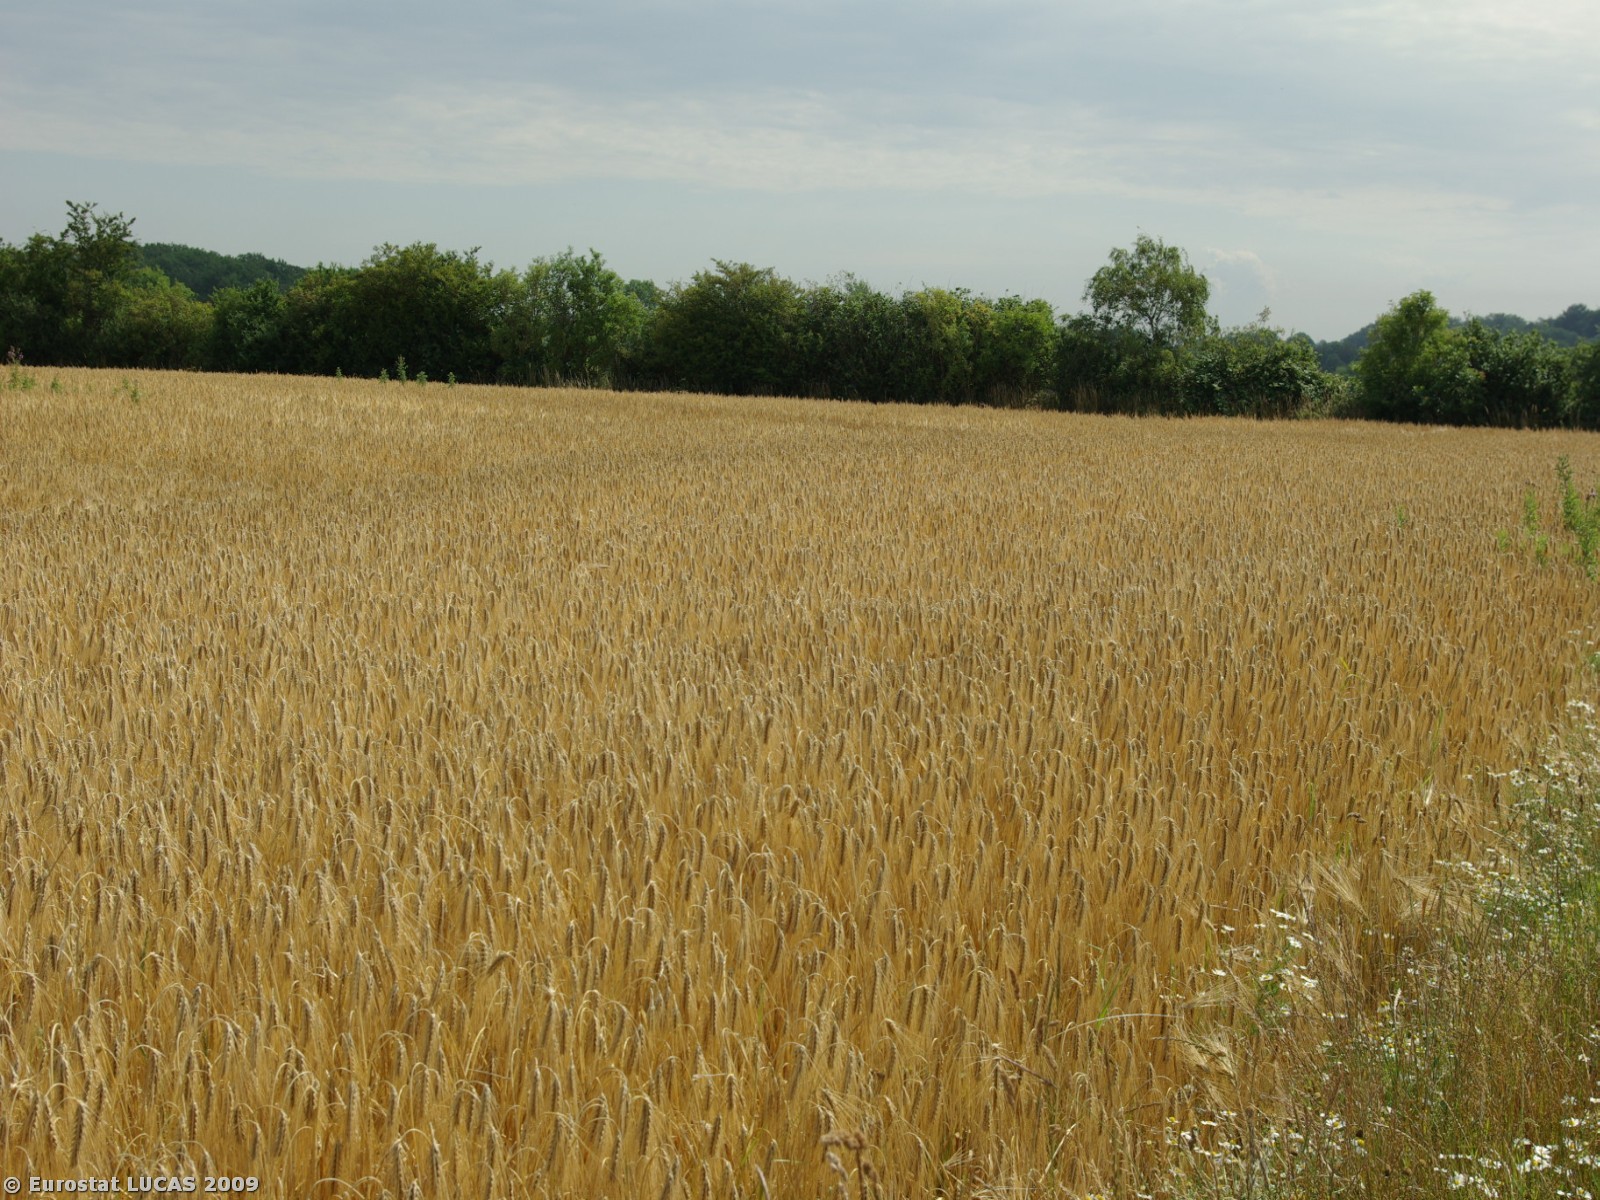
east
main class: Cropland
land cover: Barley
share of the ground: > 75 %
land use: Agriculture (excluding fallow land and kitchen gardens)
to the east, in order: Barley; Broadleaved woodland; Barley
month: July
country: DK
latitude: 54.9115
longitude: 9.8597
